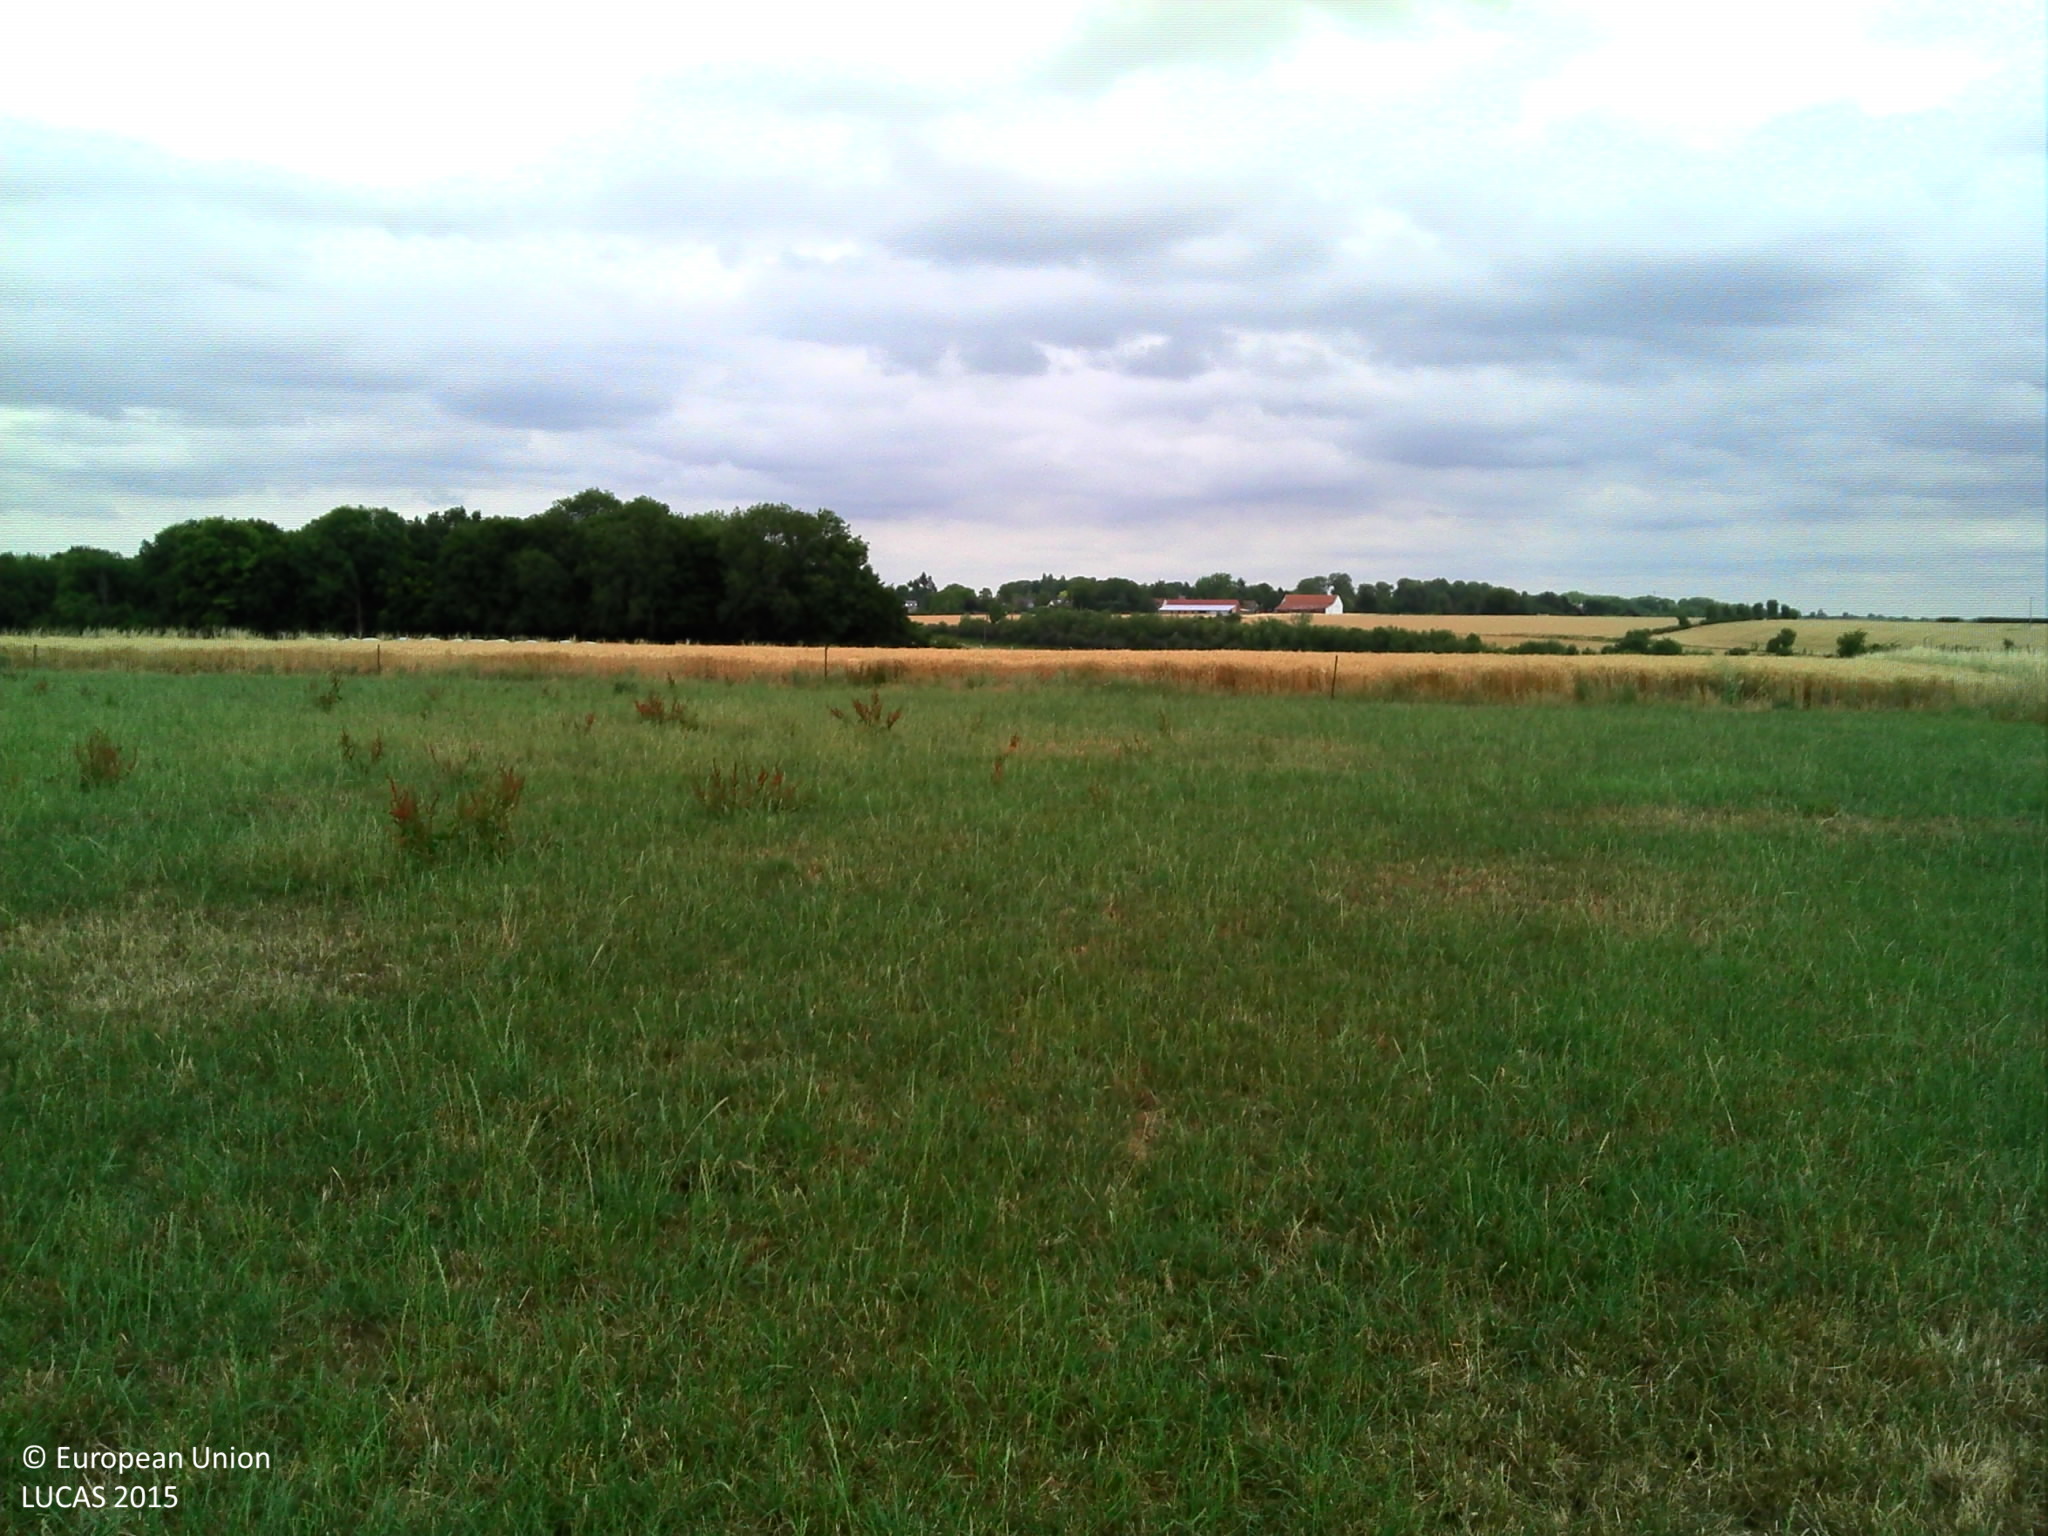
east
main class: Grassland
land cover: Grassland without tree/shrub cover
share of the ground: > 75 %
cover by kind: herbaceous plants 100 %
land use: Agriculture (excluding fallow land and kitchen gardens)
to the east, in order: Grassland without tree/shrub cover; Fences; Durum wheat; Tracks; Grassland without tree/shrub cover; Fences; Tracks; Fences; Grassland without tree/shrub cover
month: July
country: FR
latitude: 49.8153
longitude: 2.3011
